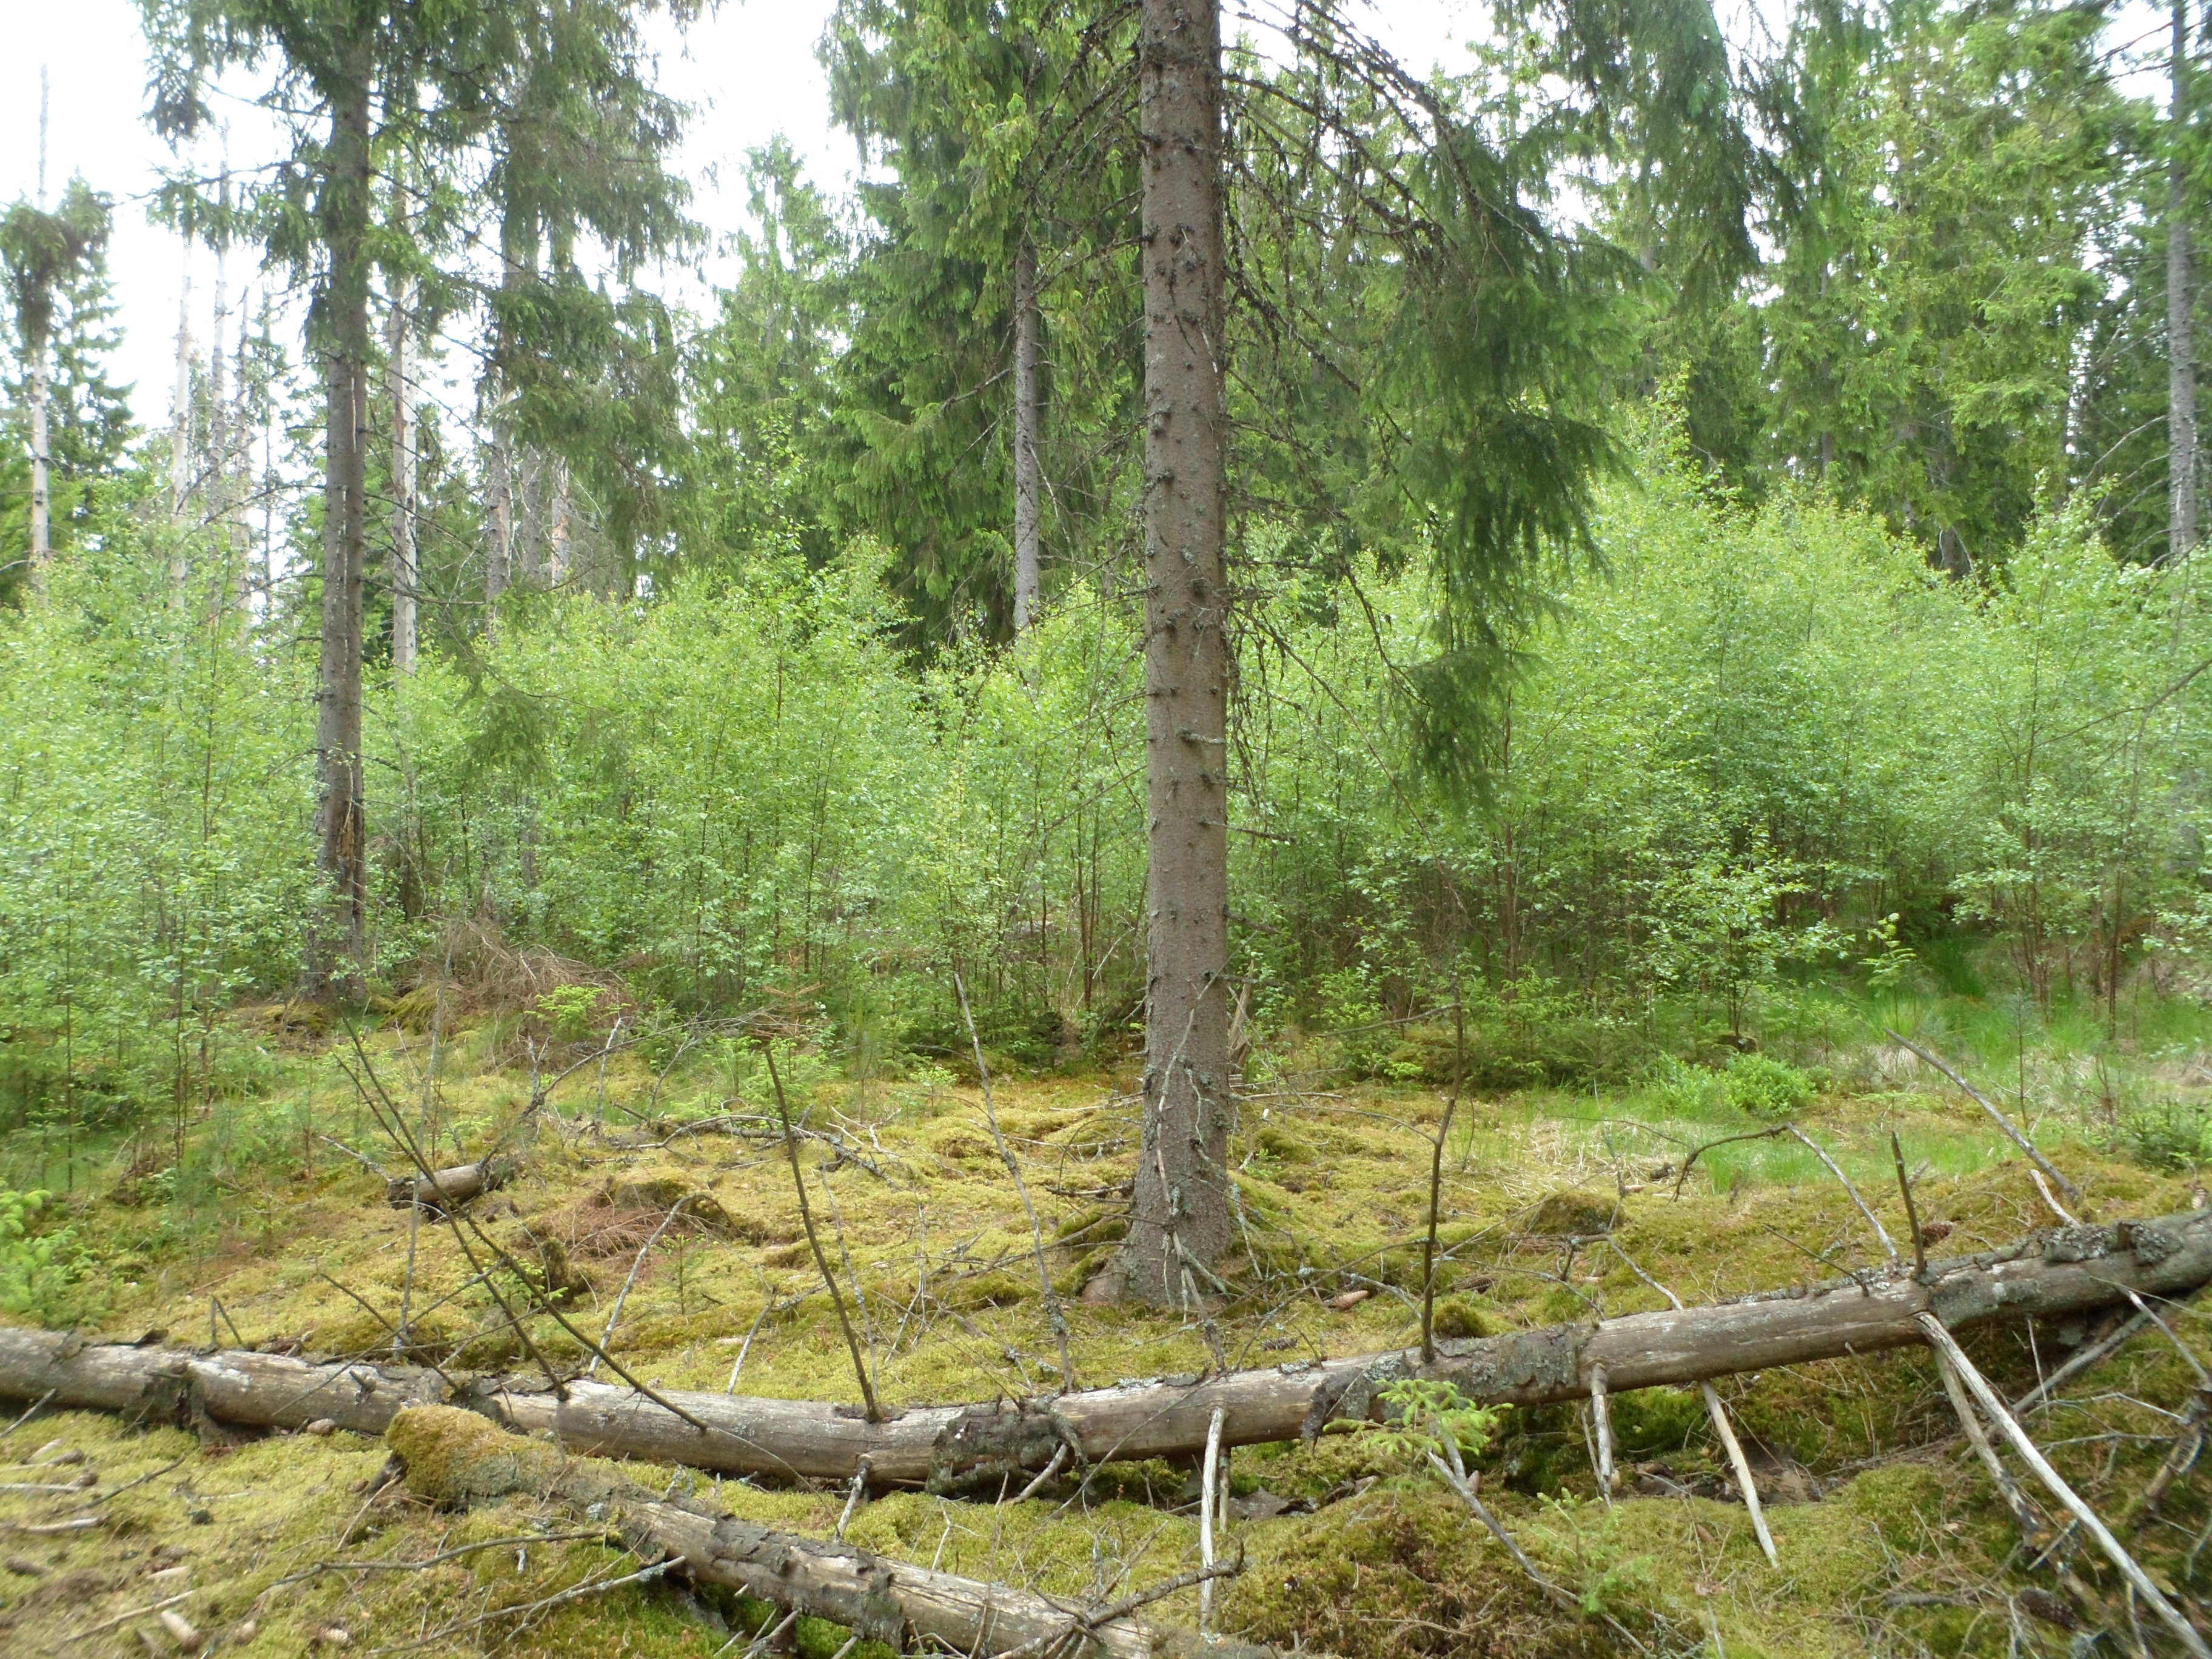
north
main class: Woodland
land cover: Spruce dominated coniferous woodland
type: boreal forest
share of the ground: 50 - 75 %
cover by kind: coniferous forest trees 65 %, lichens and mosses 20 %, broadleaved forest trees 10 %, shrubs 5 %
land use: Forestry
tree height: > 5 m
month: June
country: SE
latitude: 56.7933
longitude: 14.4993
